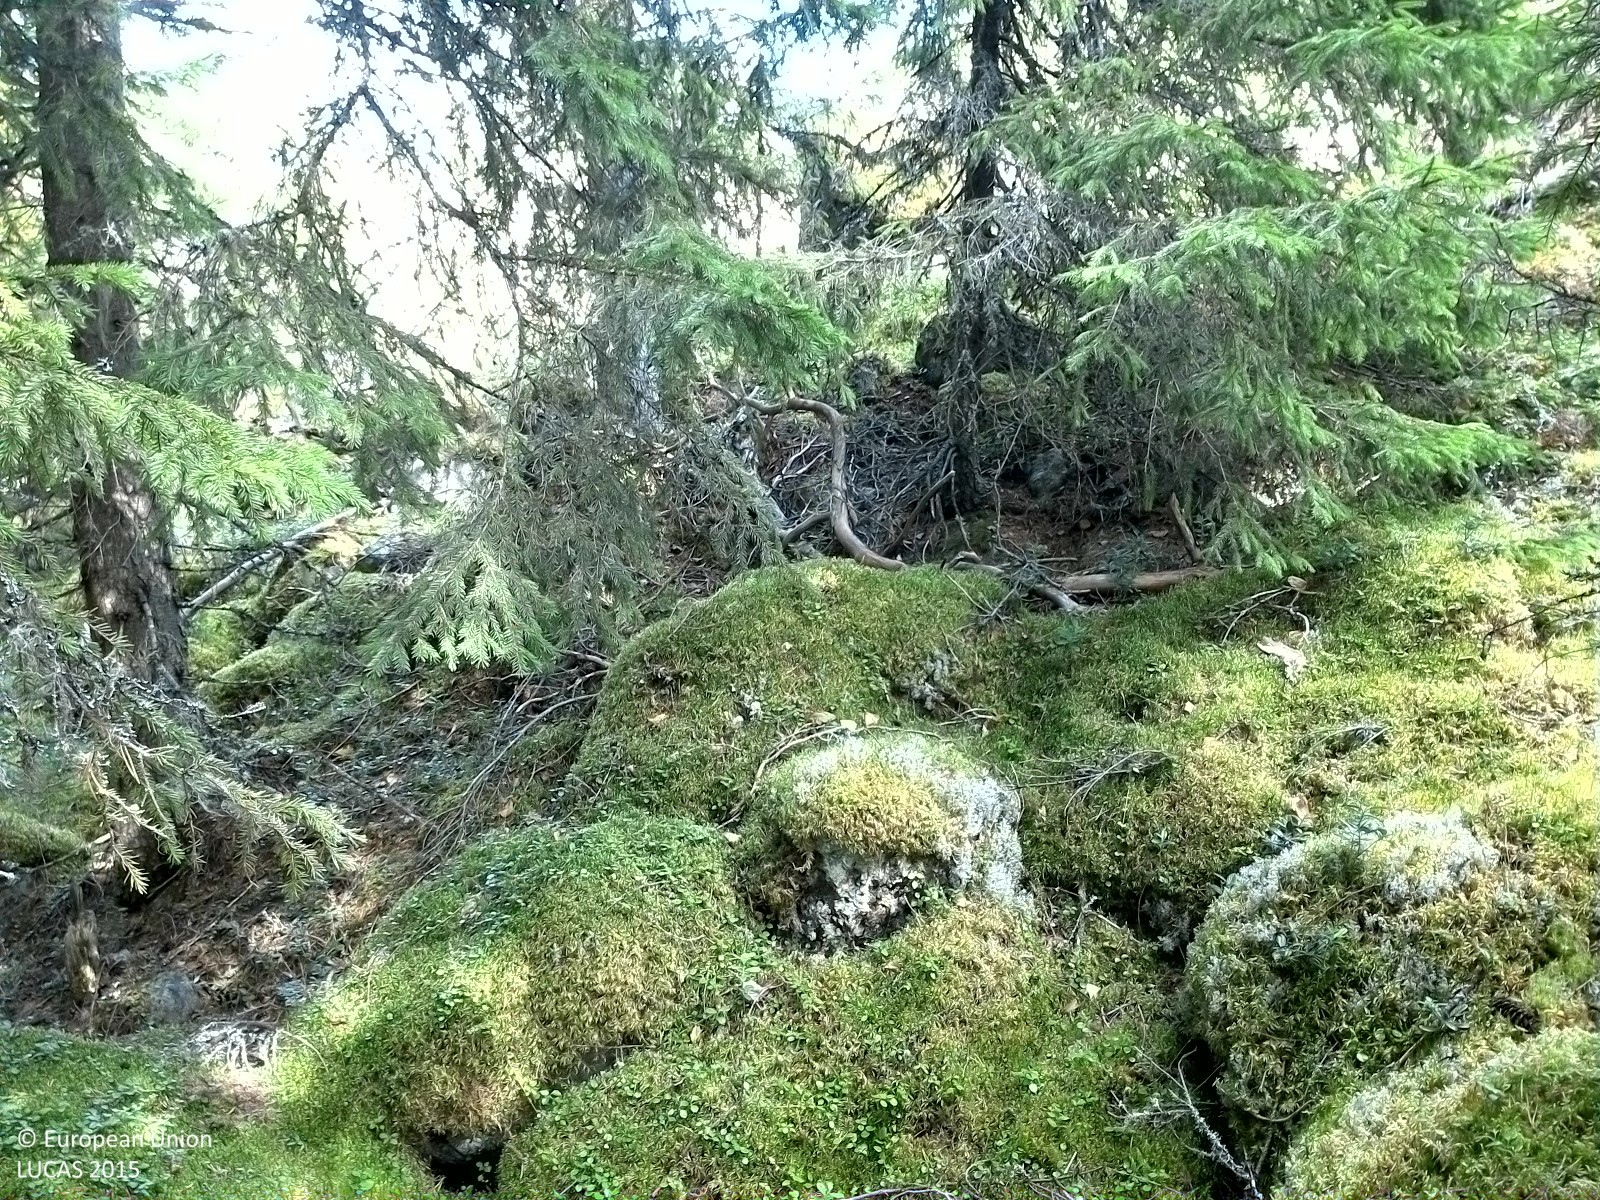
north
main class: Woodland
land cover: Spruce dominated coniferous woodland
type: boreal forest
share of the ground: > 75 %
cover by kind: coniferous forest trees 80 %, lichens and mosses 20 %
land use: Forestry
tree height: > 5 m
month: September
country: SE
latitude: 62.4567
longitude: 16.4344
